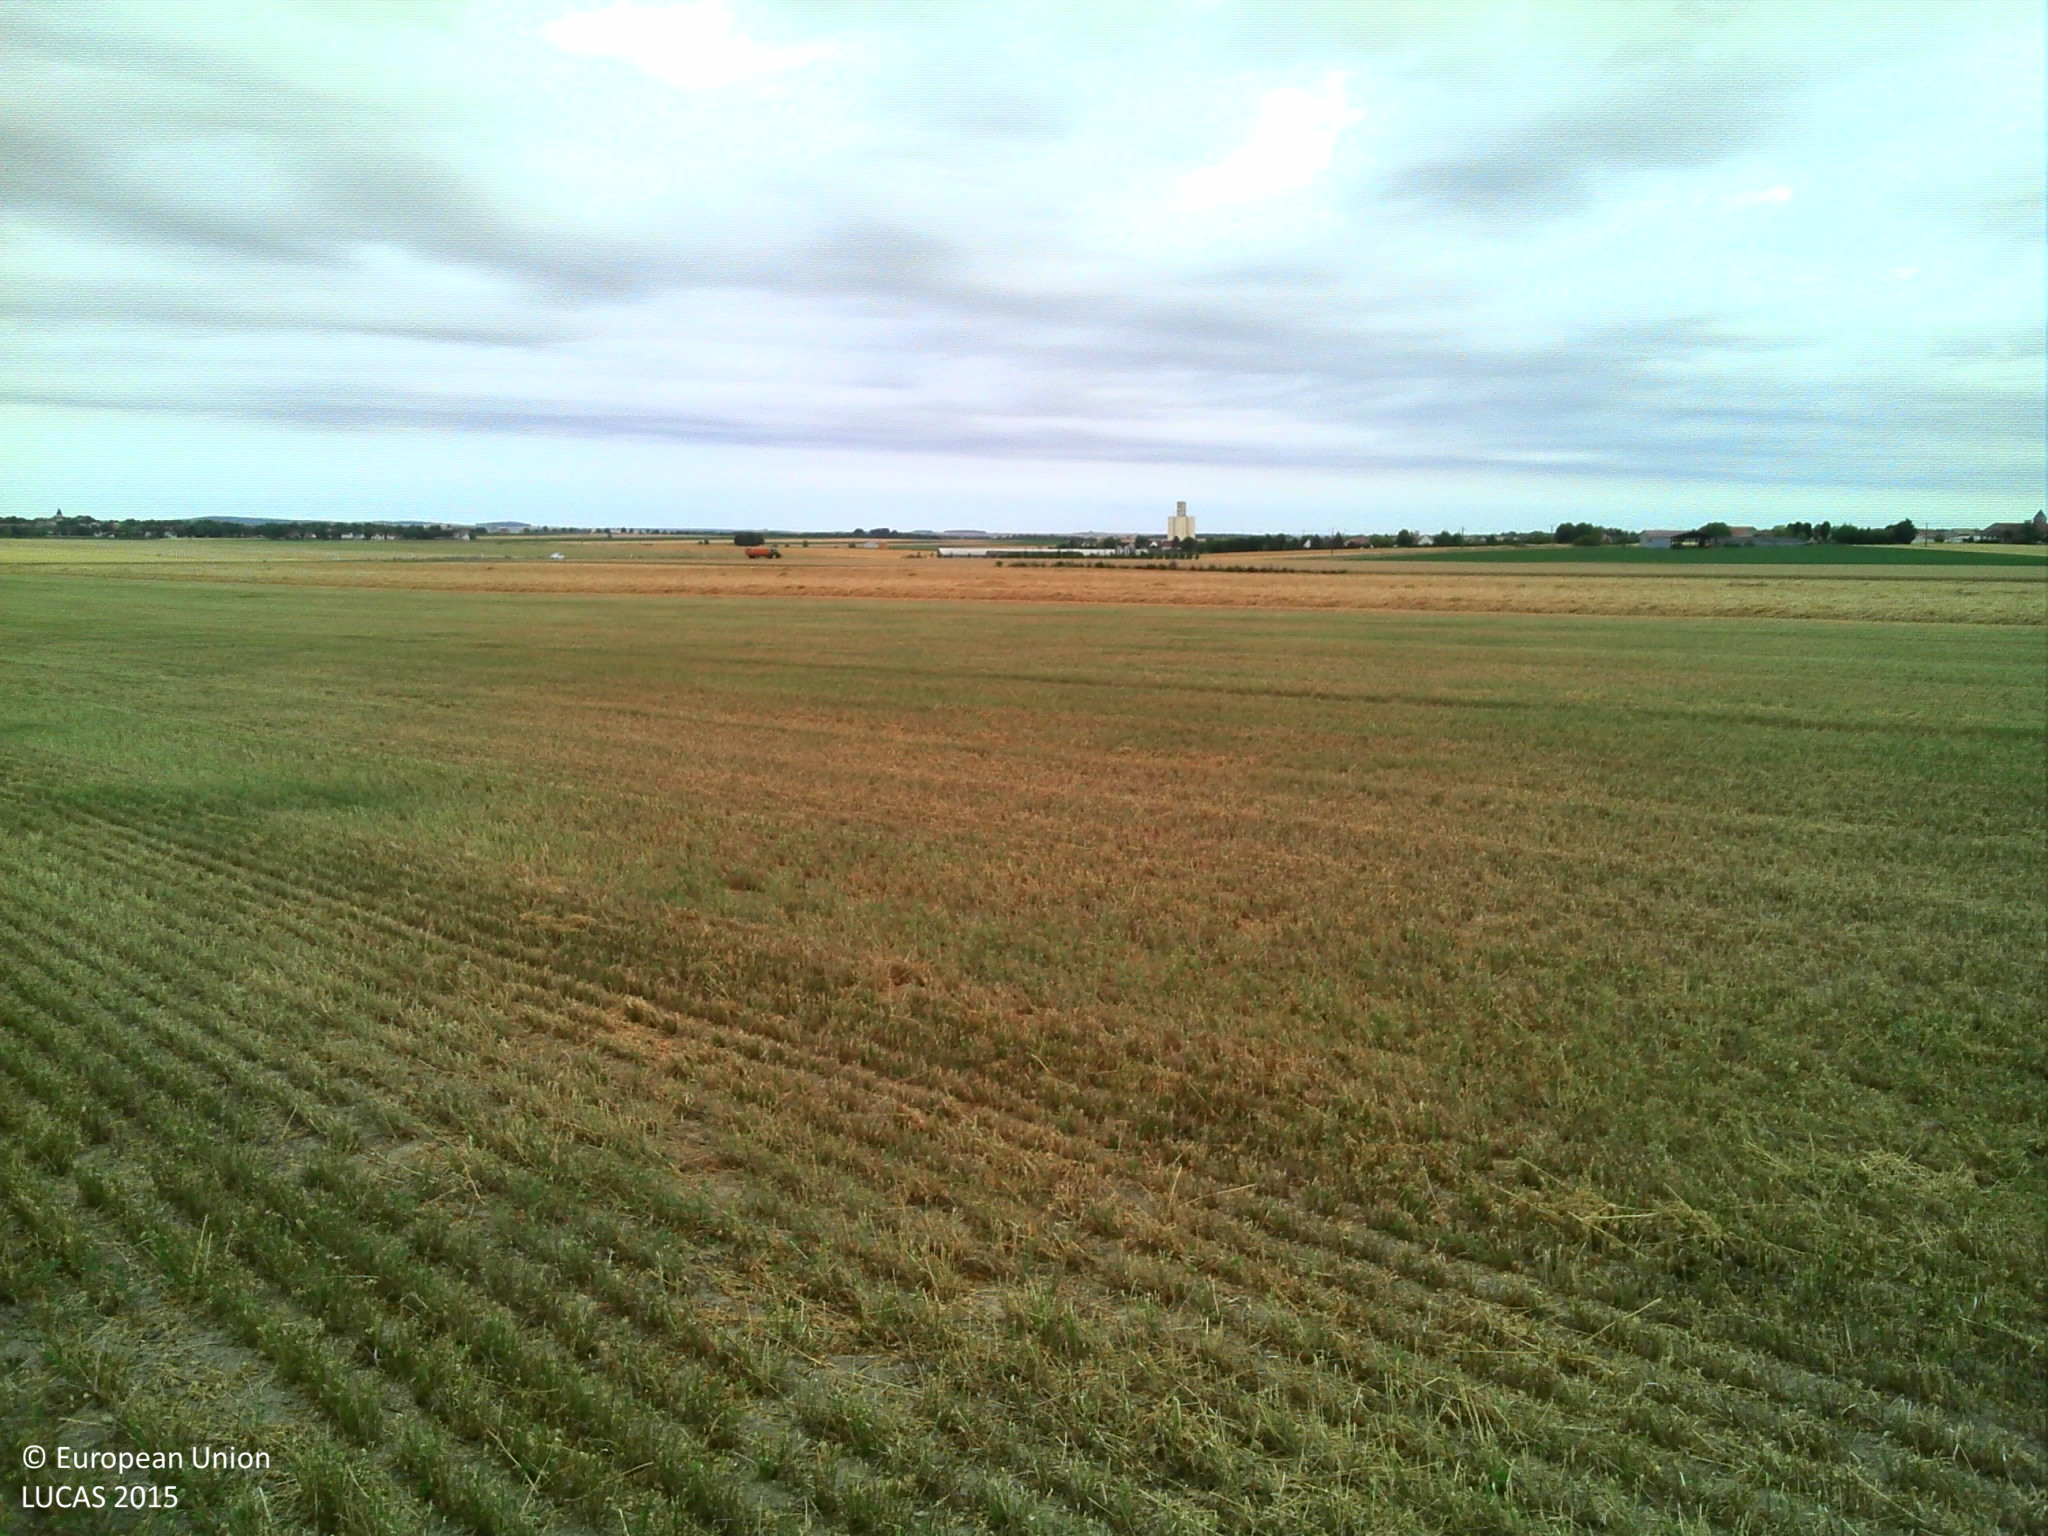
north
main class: Cropland
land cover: Lucerne
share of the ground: > 75 %
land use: Agriculture (excluding fallow land and kitchen gardens)
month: July
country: FR
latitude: 49.3278
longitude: 4.0923
